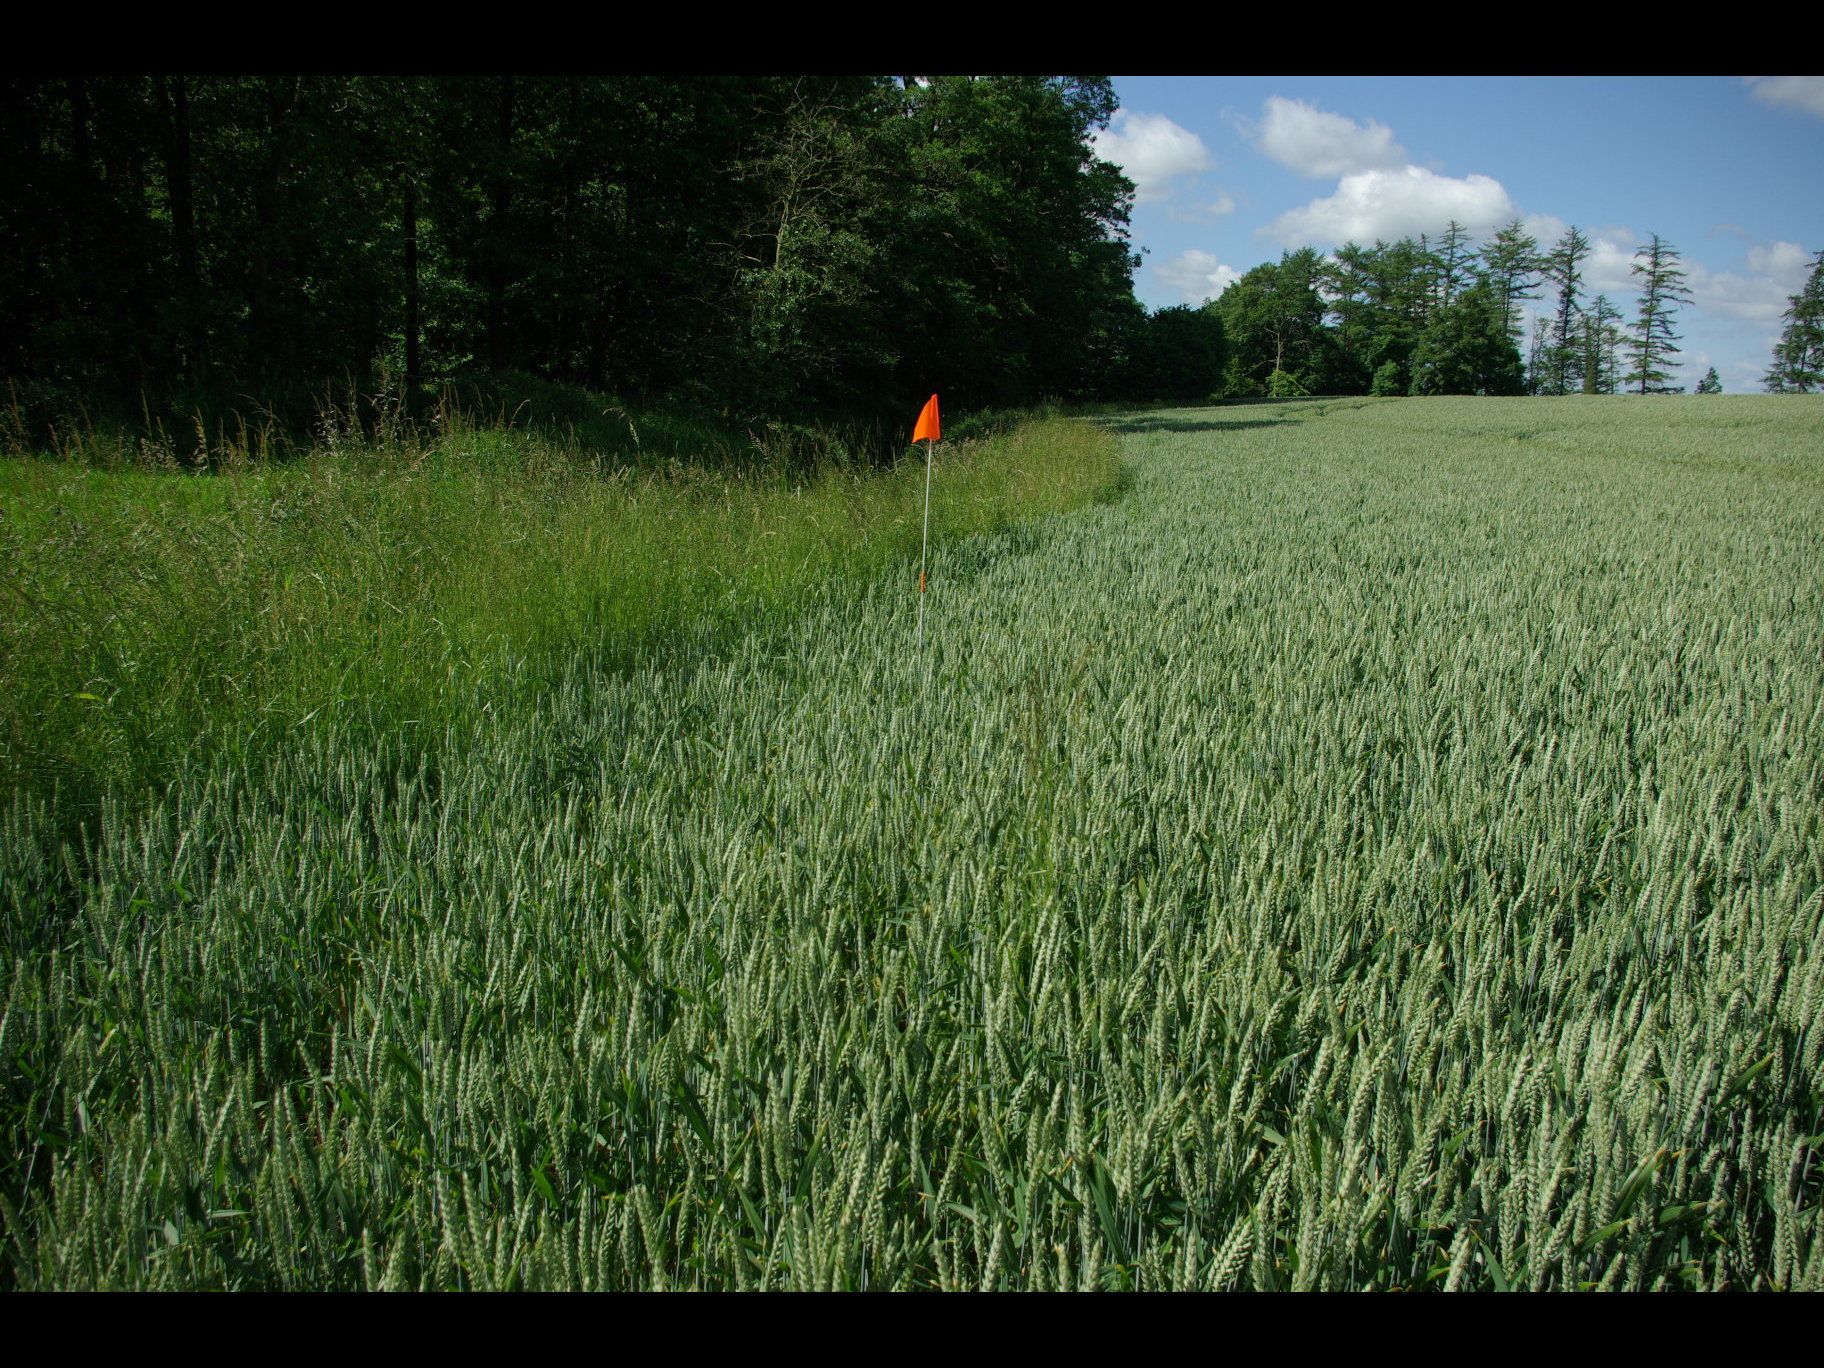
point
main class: Cropland
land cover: Common wheat
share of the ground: > 75 %
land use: Agriculture (excluding fallow land and kitchen gardens)
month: June
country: DE
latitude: 54.3724
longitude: 9.8923
